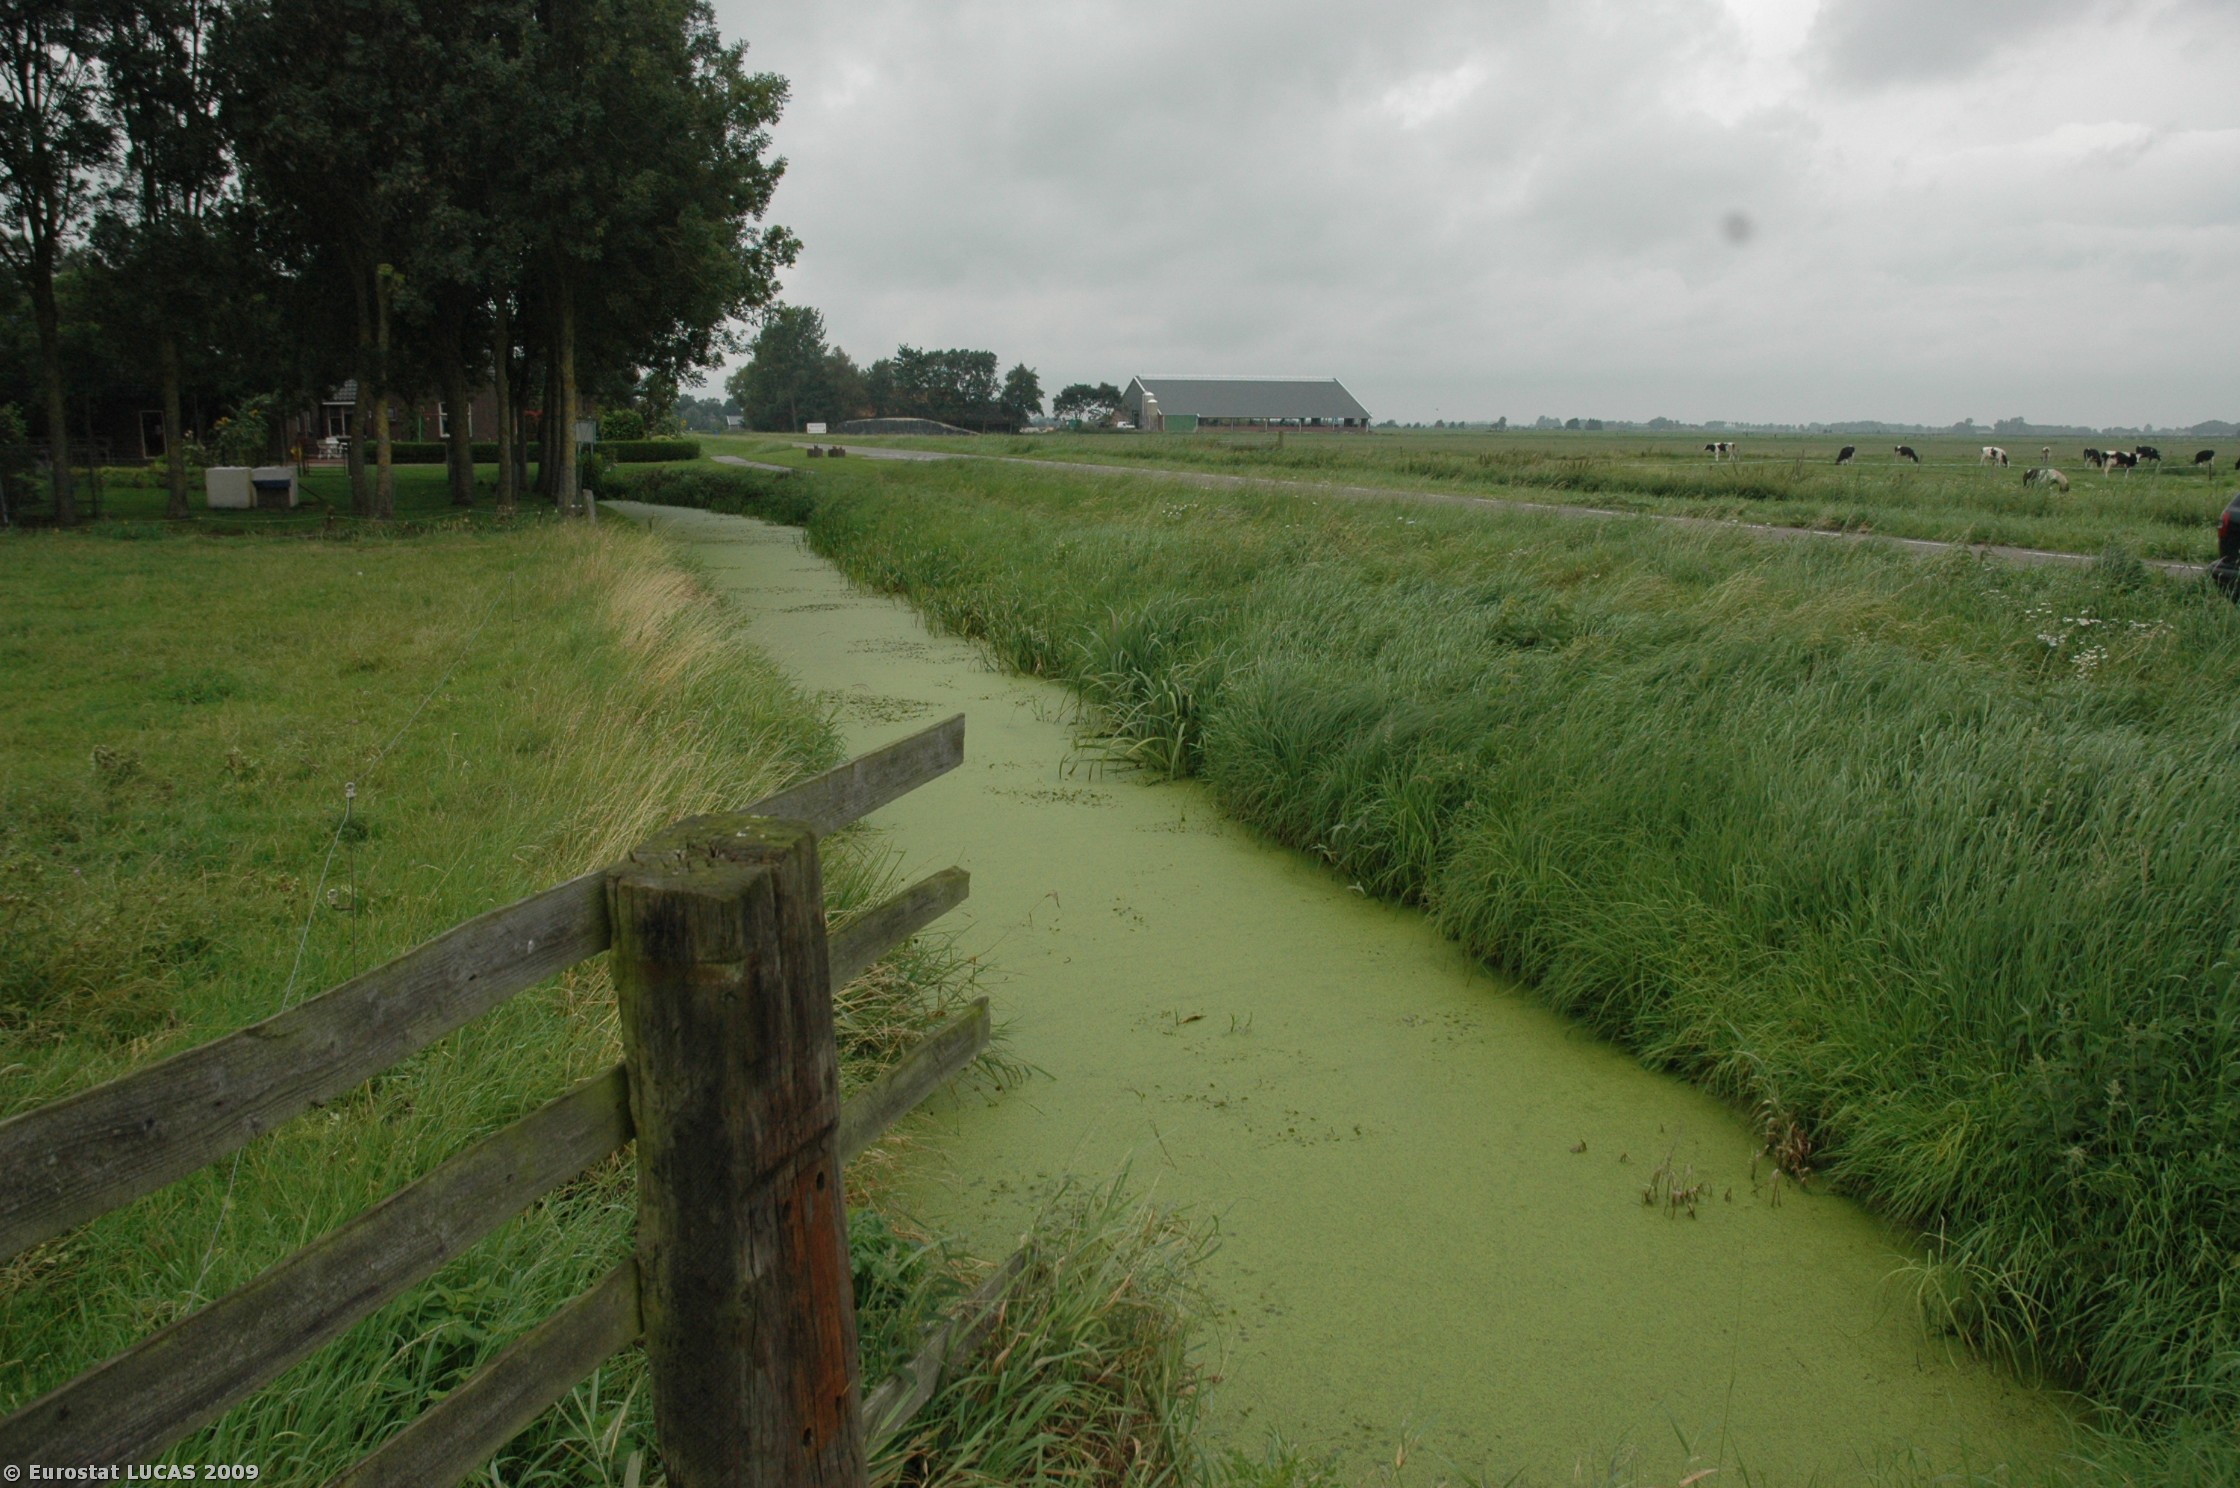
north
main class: Grassland
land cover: Grassland without tree/shrub cover
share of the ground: > 75 %
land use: Agriculture (excluding fallow land and kitchen gardens)
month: August
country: NL
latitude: 52.5641
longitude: 6.0605
